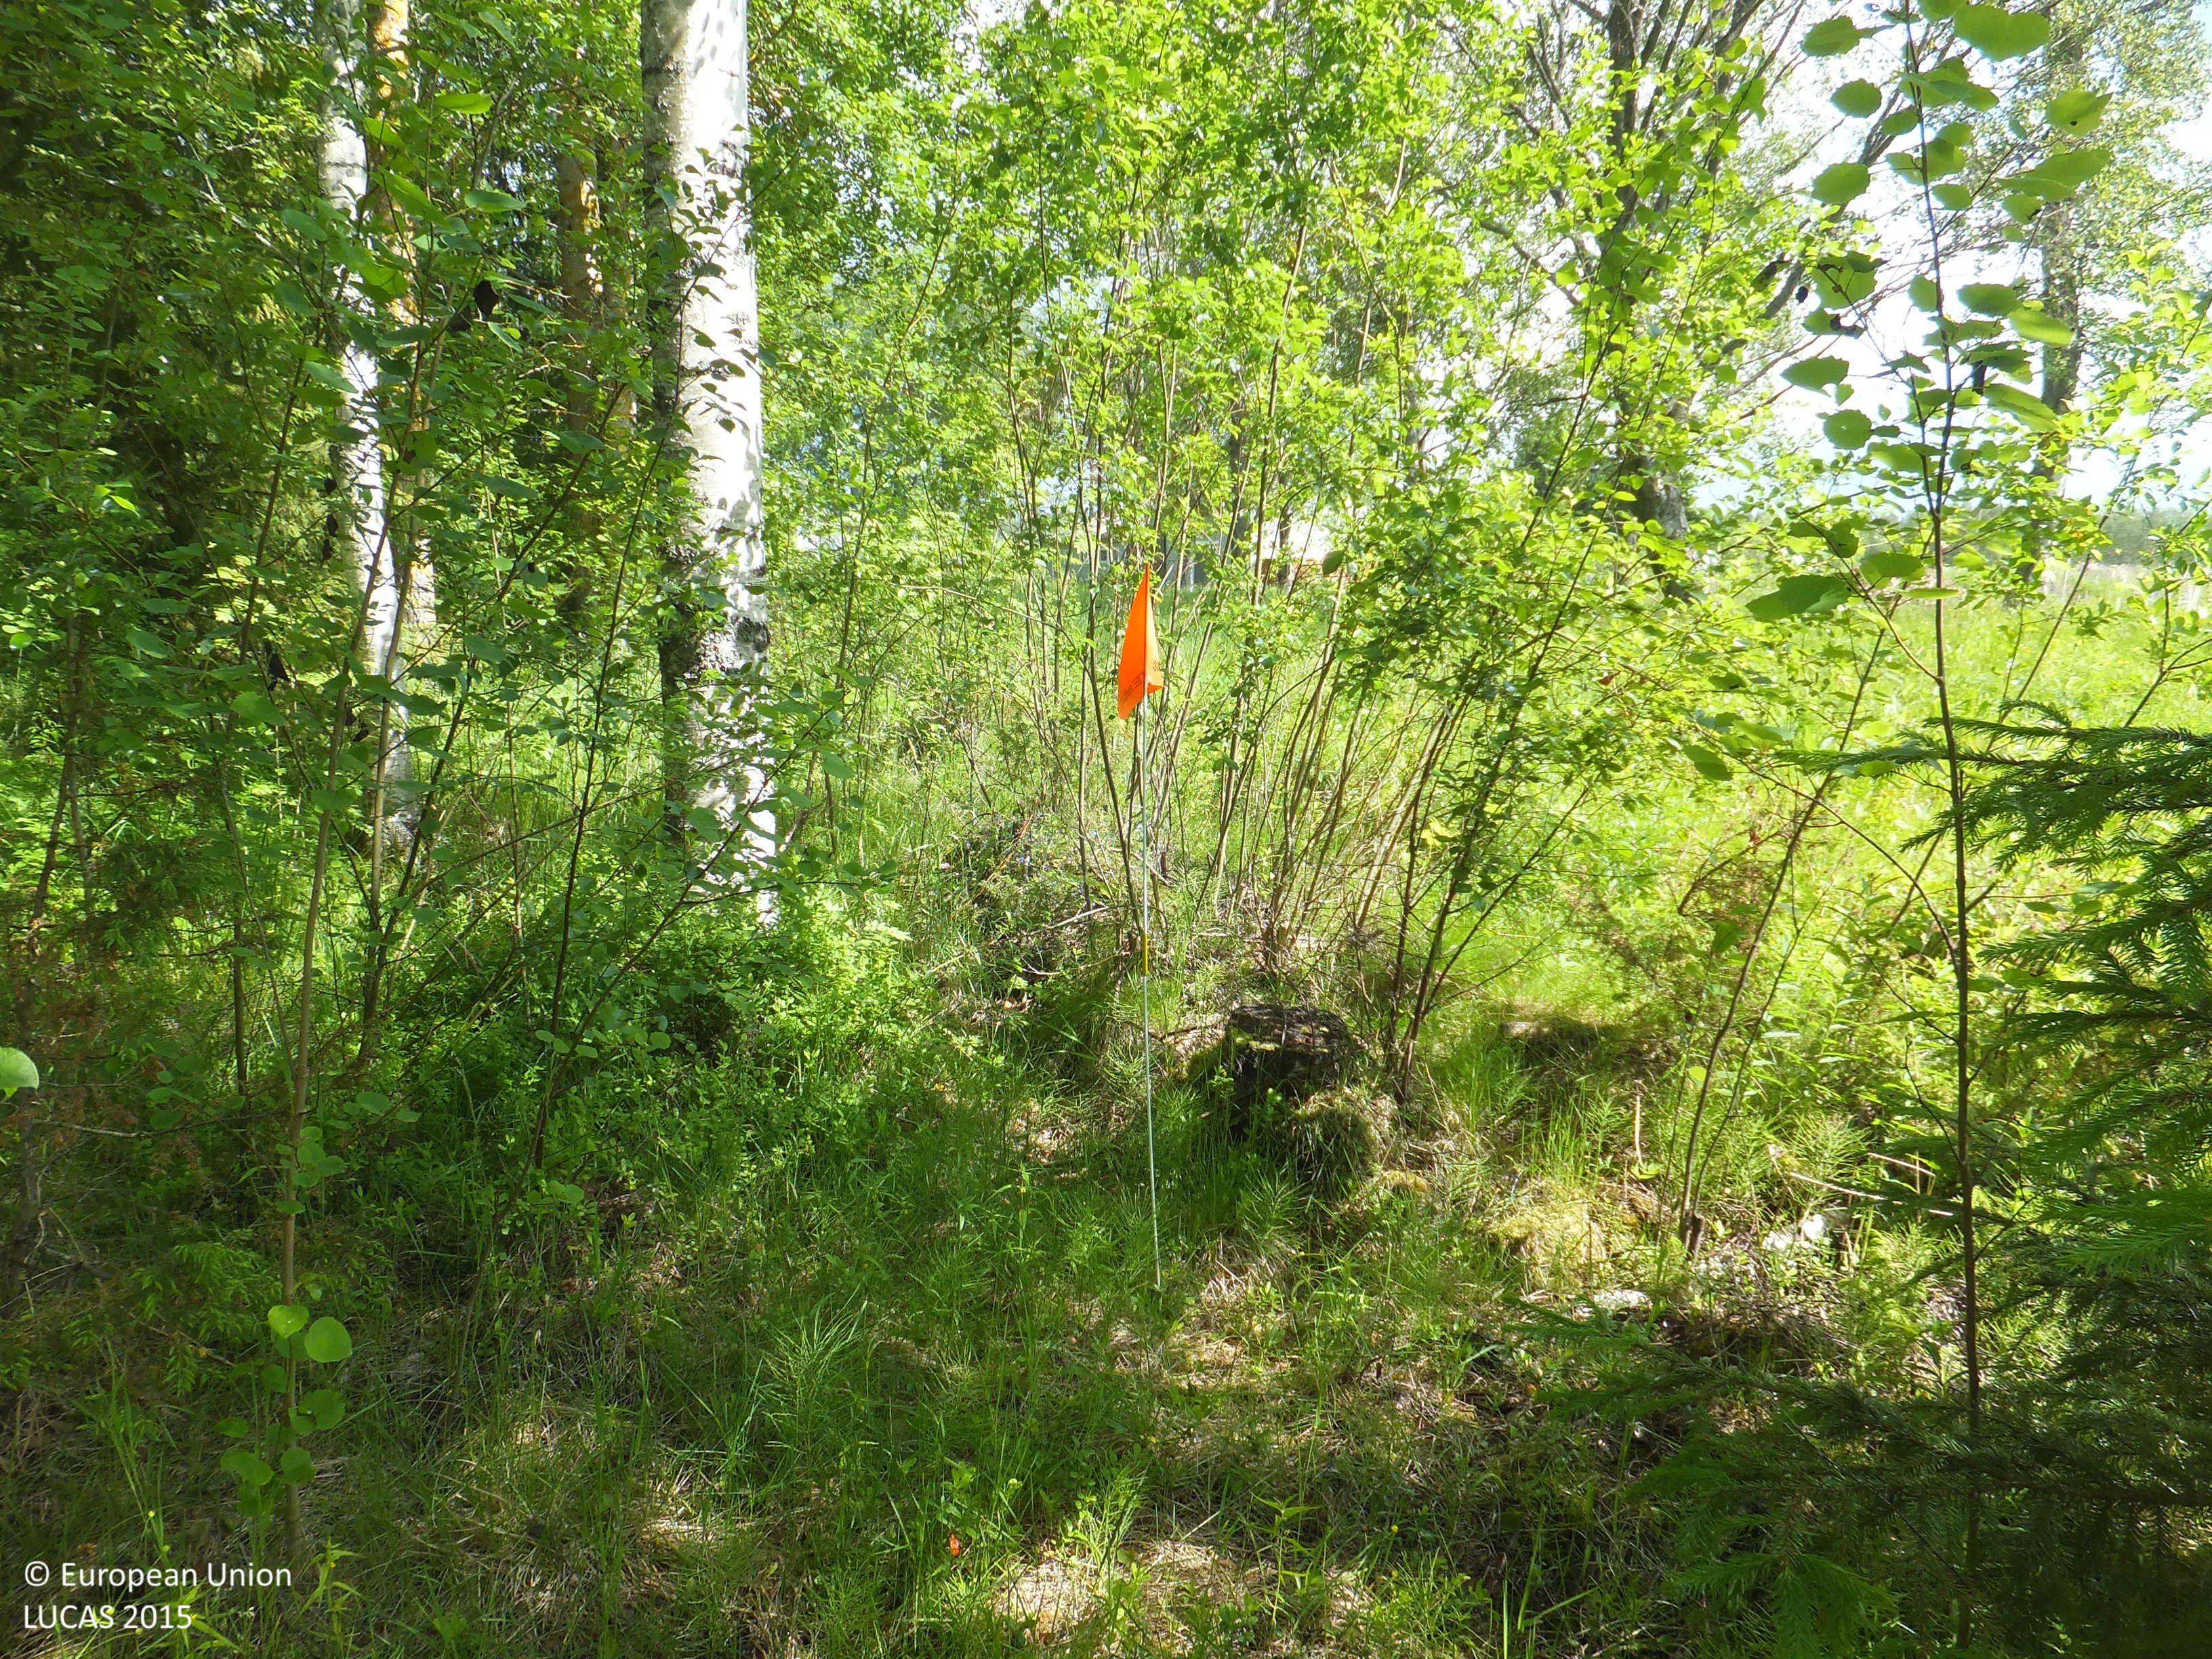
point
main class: Woodland
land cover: Spruce dominated mixed woodland
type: boreal forest
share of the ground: 50 - 75 %
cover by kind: broadleaved forest trees 40 %, herbaceous plants 25 %, coniferous forest trees 20 %, shrubs 15 %
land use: Residential
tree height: > 5 m
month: June
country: FI
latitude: 63.2096
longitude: 23.9329
